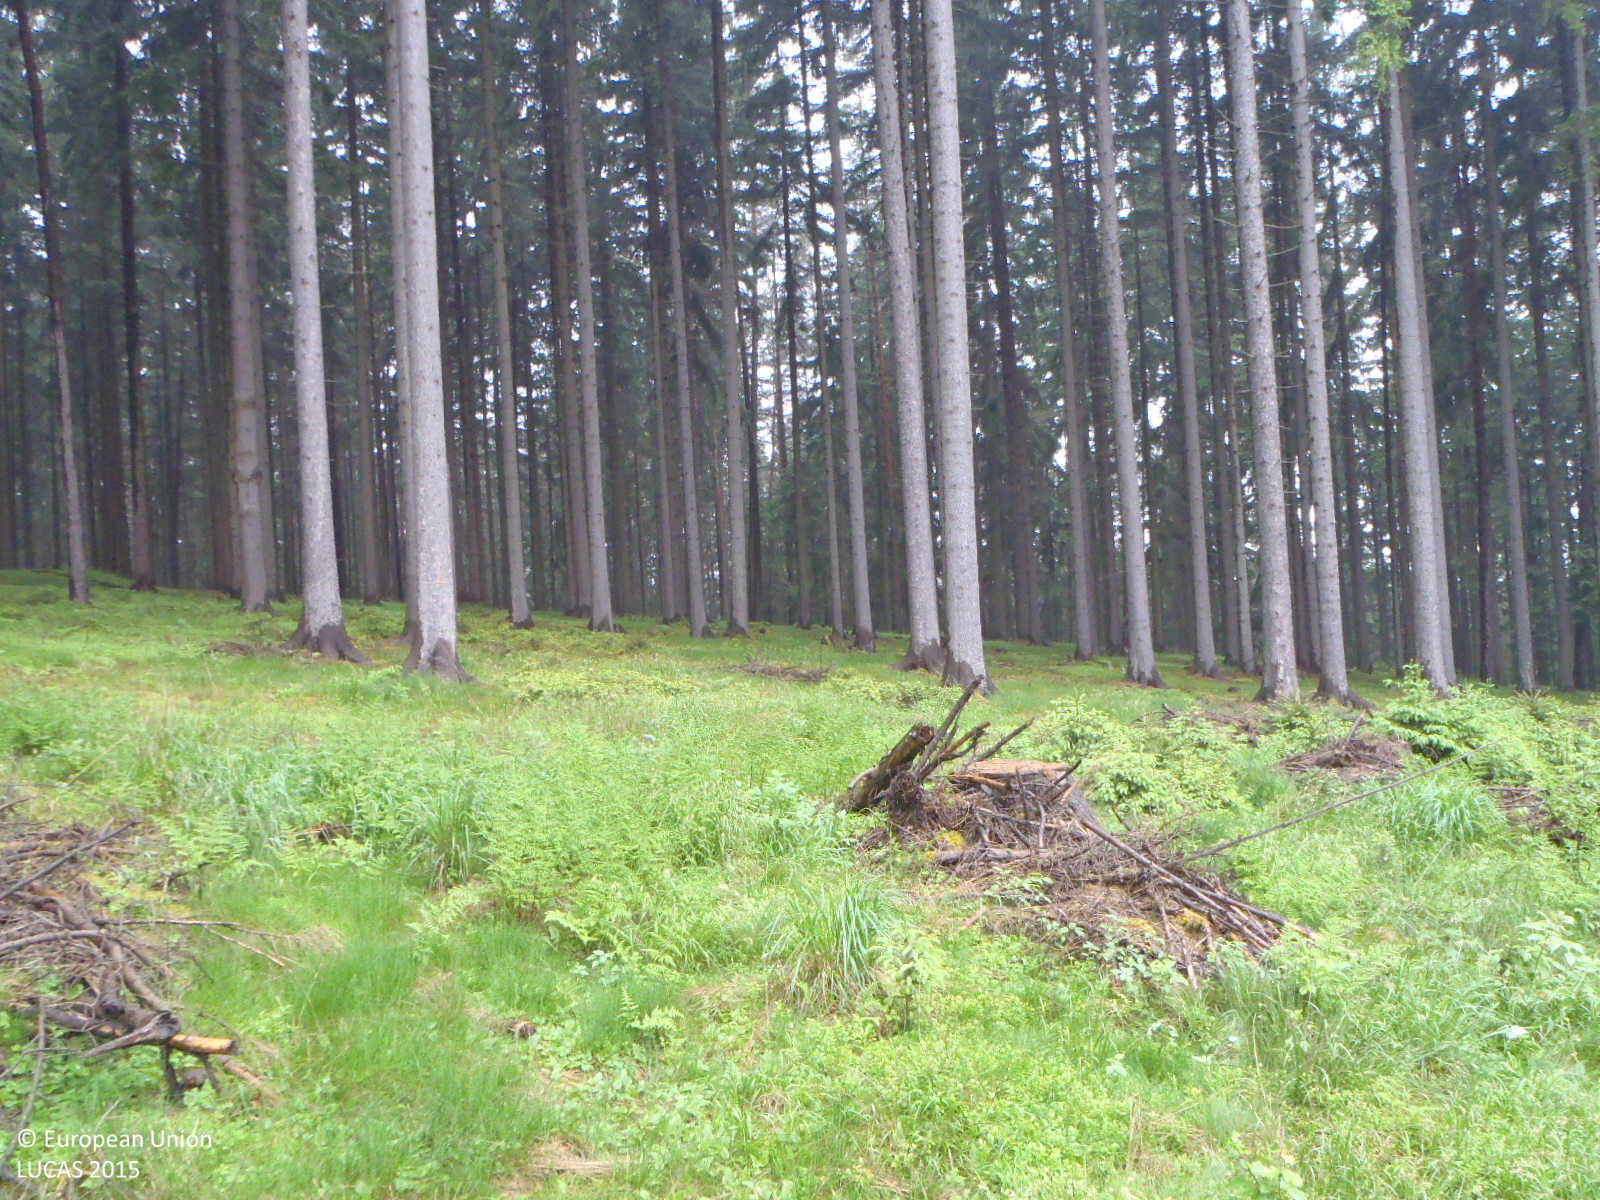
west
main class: Woodland
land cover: Spruce dominated coniferous woodland
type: hemiboreal forest and nemoral coniferous forest and mixed broadleaved-coniferous forest
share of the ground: 25 - 50 %
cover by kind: coniferous forest trees 40 %, herbaceous plants 35 %, shrubs 10 %, lichens and mosses 10 %, broadleaved forest trees 5 %
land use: Forestry
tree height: < 5 m
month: May
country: CZ
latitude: 48.8047
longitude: 14.3441
